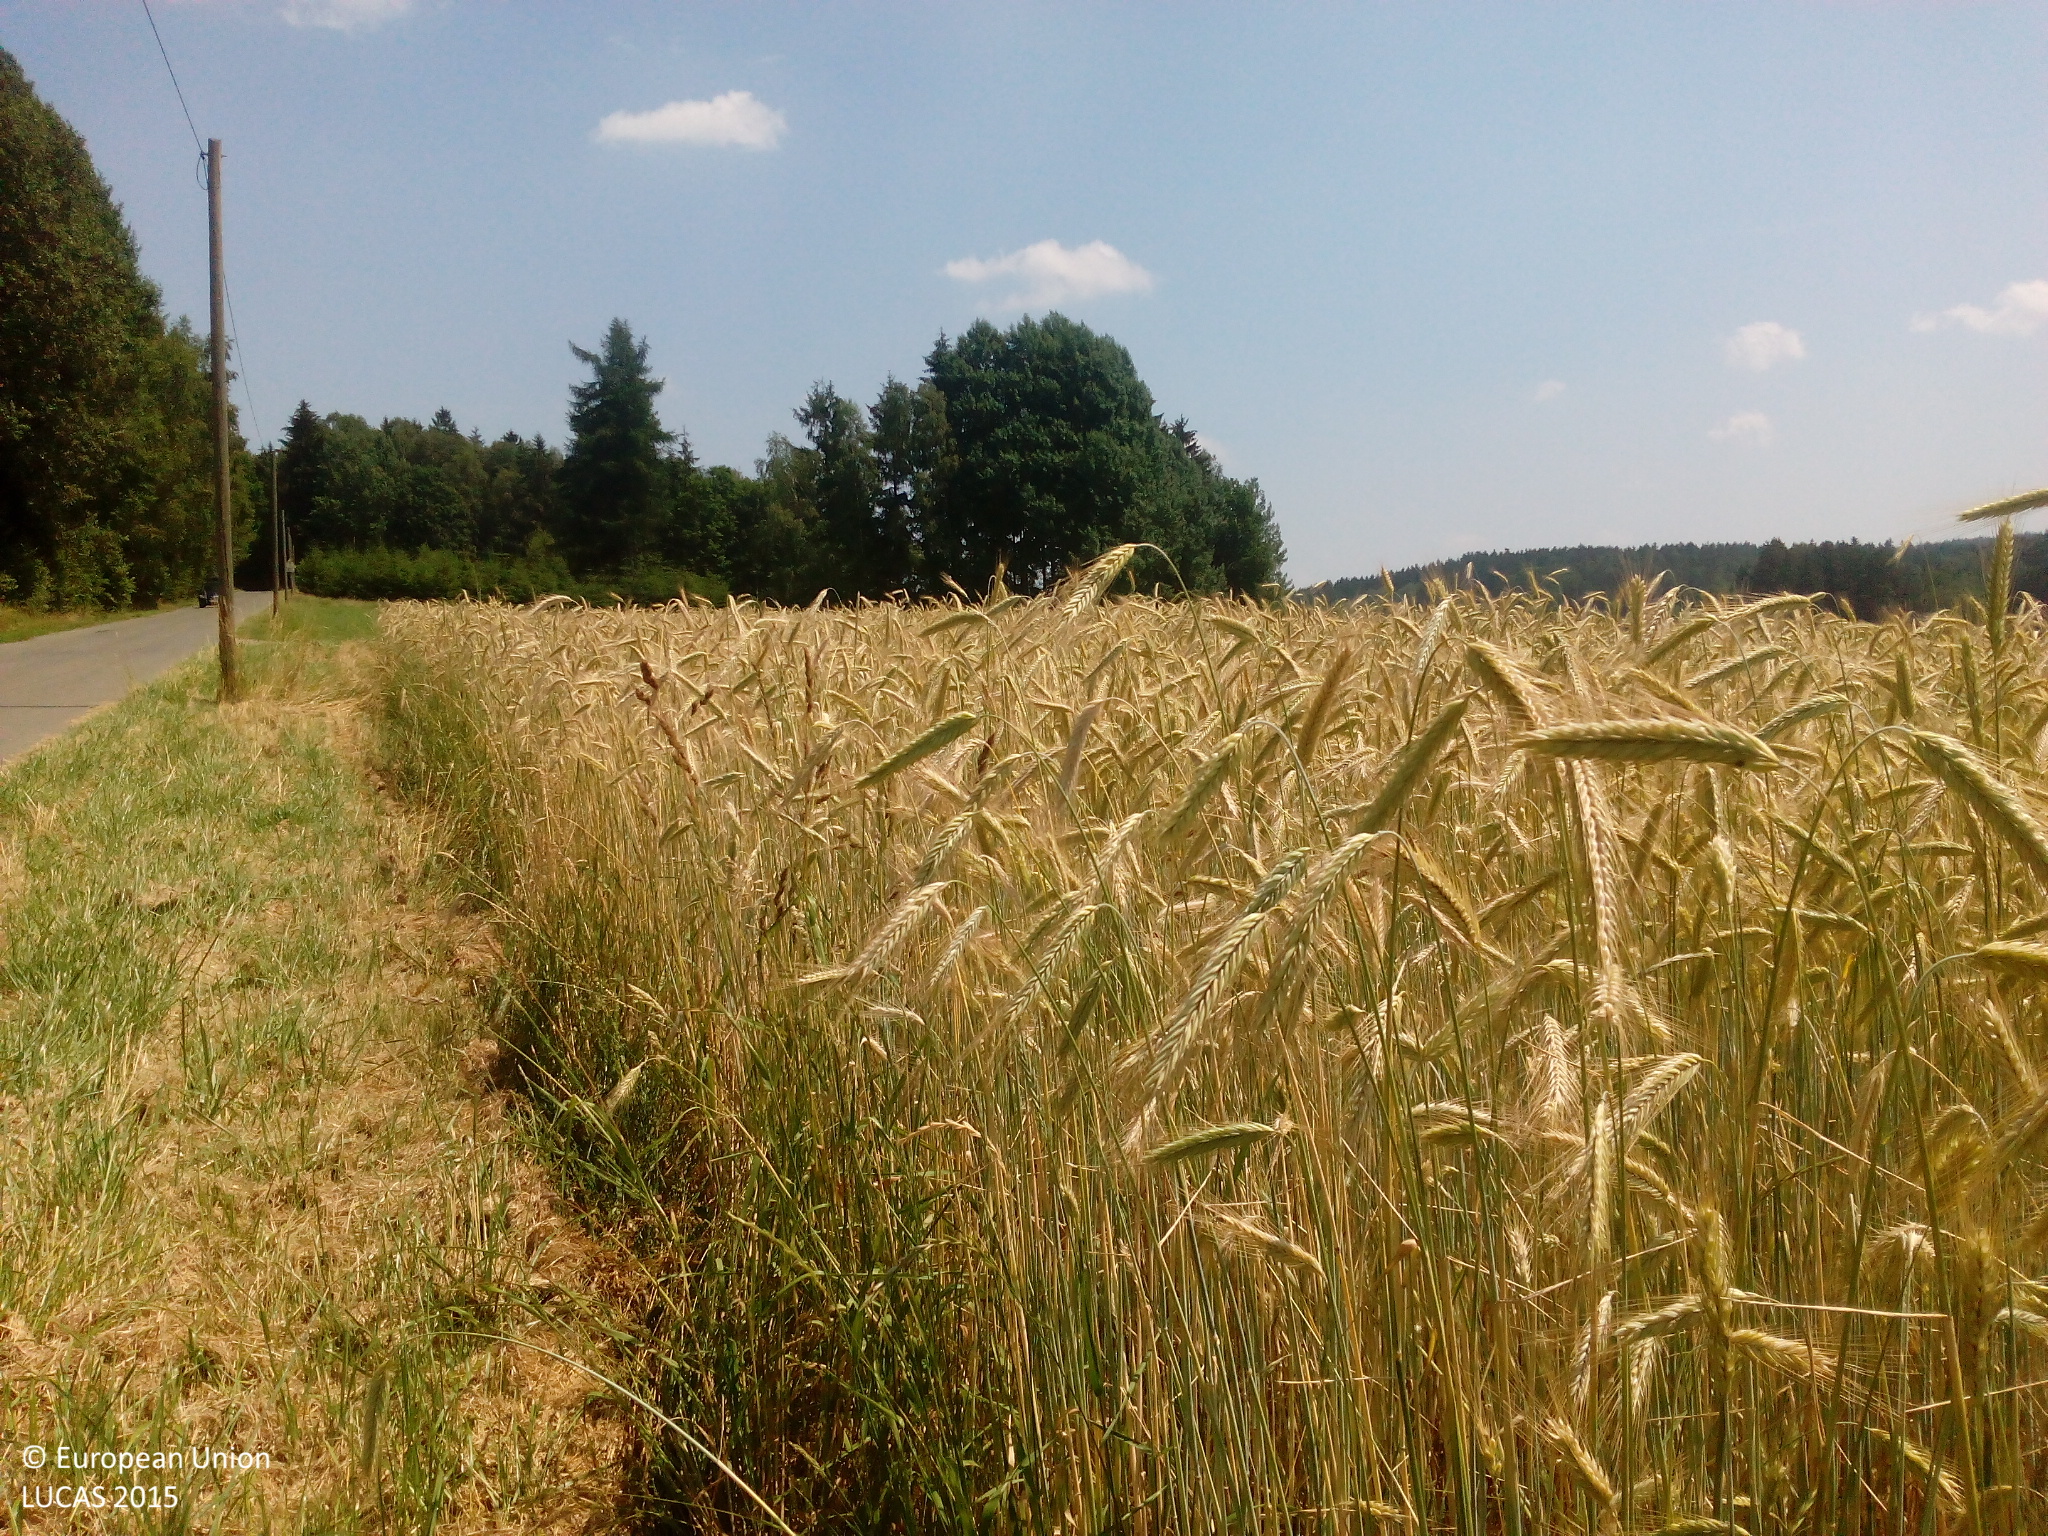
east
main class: Cropland
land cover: Rye
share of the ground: > 75 %
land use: Agriculture (excluding fallow land and kitchen gardens)
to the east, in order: Rye; Potatoes; Barley; Grass margins; Tracks; Grass margins; Spruce dominated mixed woodland; Spruce dominated coniferous woodland; Groves; Grassland without tree/shrub cover
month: July
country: DE
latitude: 49.5643
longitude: 12.4468
